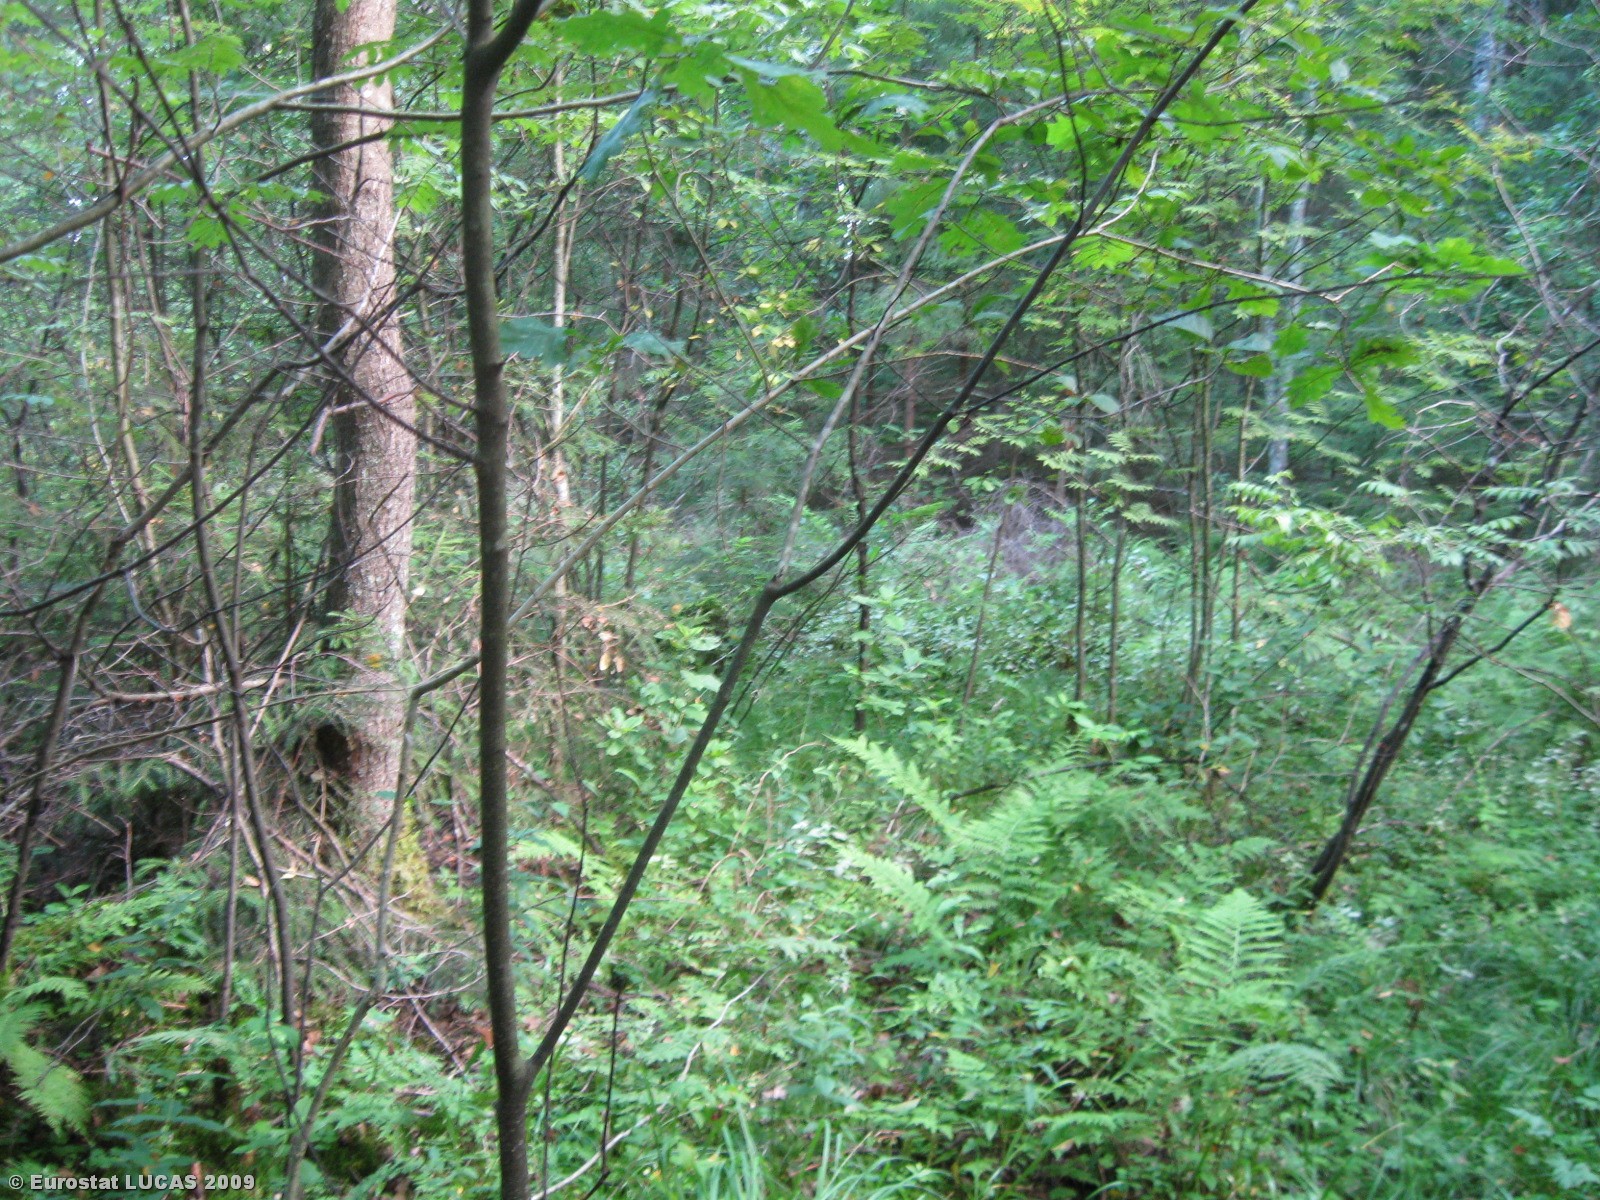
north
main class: Woodland
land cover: Mixed woodland
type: hemiboreal forest and nemoral coniferous forest and mixed broadleaved-coniferous forest
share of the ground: > 75 %
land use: Forestry
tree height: > 5 m
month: August
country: LT
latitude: 55.2441
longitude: 22.6953
